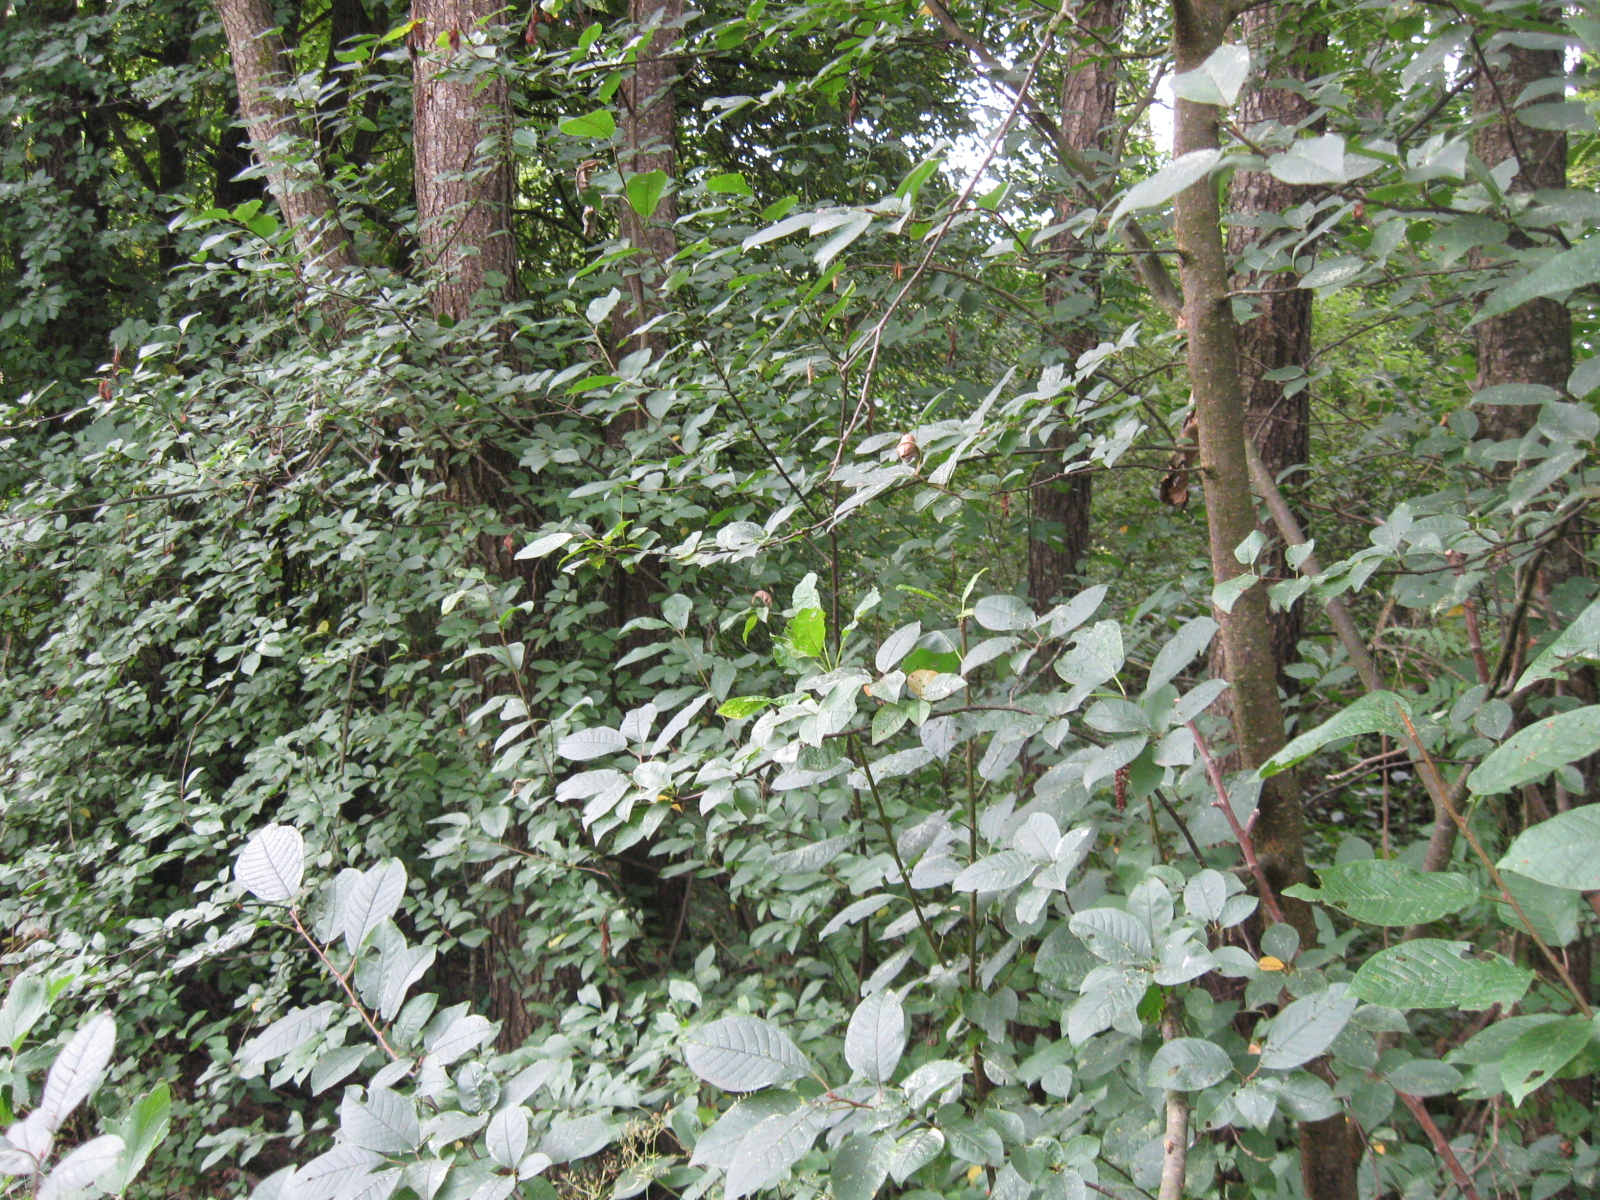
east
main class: Woodland
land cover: Broadleaved woodland
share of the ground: > 75 %
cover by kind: broadleaved forest trees 85 %, herbaceous plants 10 %, shrubs 5 %
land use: Forestry
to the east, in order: Broadleaved woodland; Spontaneously vegetated surfaces; Pine dominated coniferous woodland; Broadleaved woodland
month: July
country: LT
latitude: 54.4198
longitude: 24.3868
